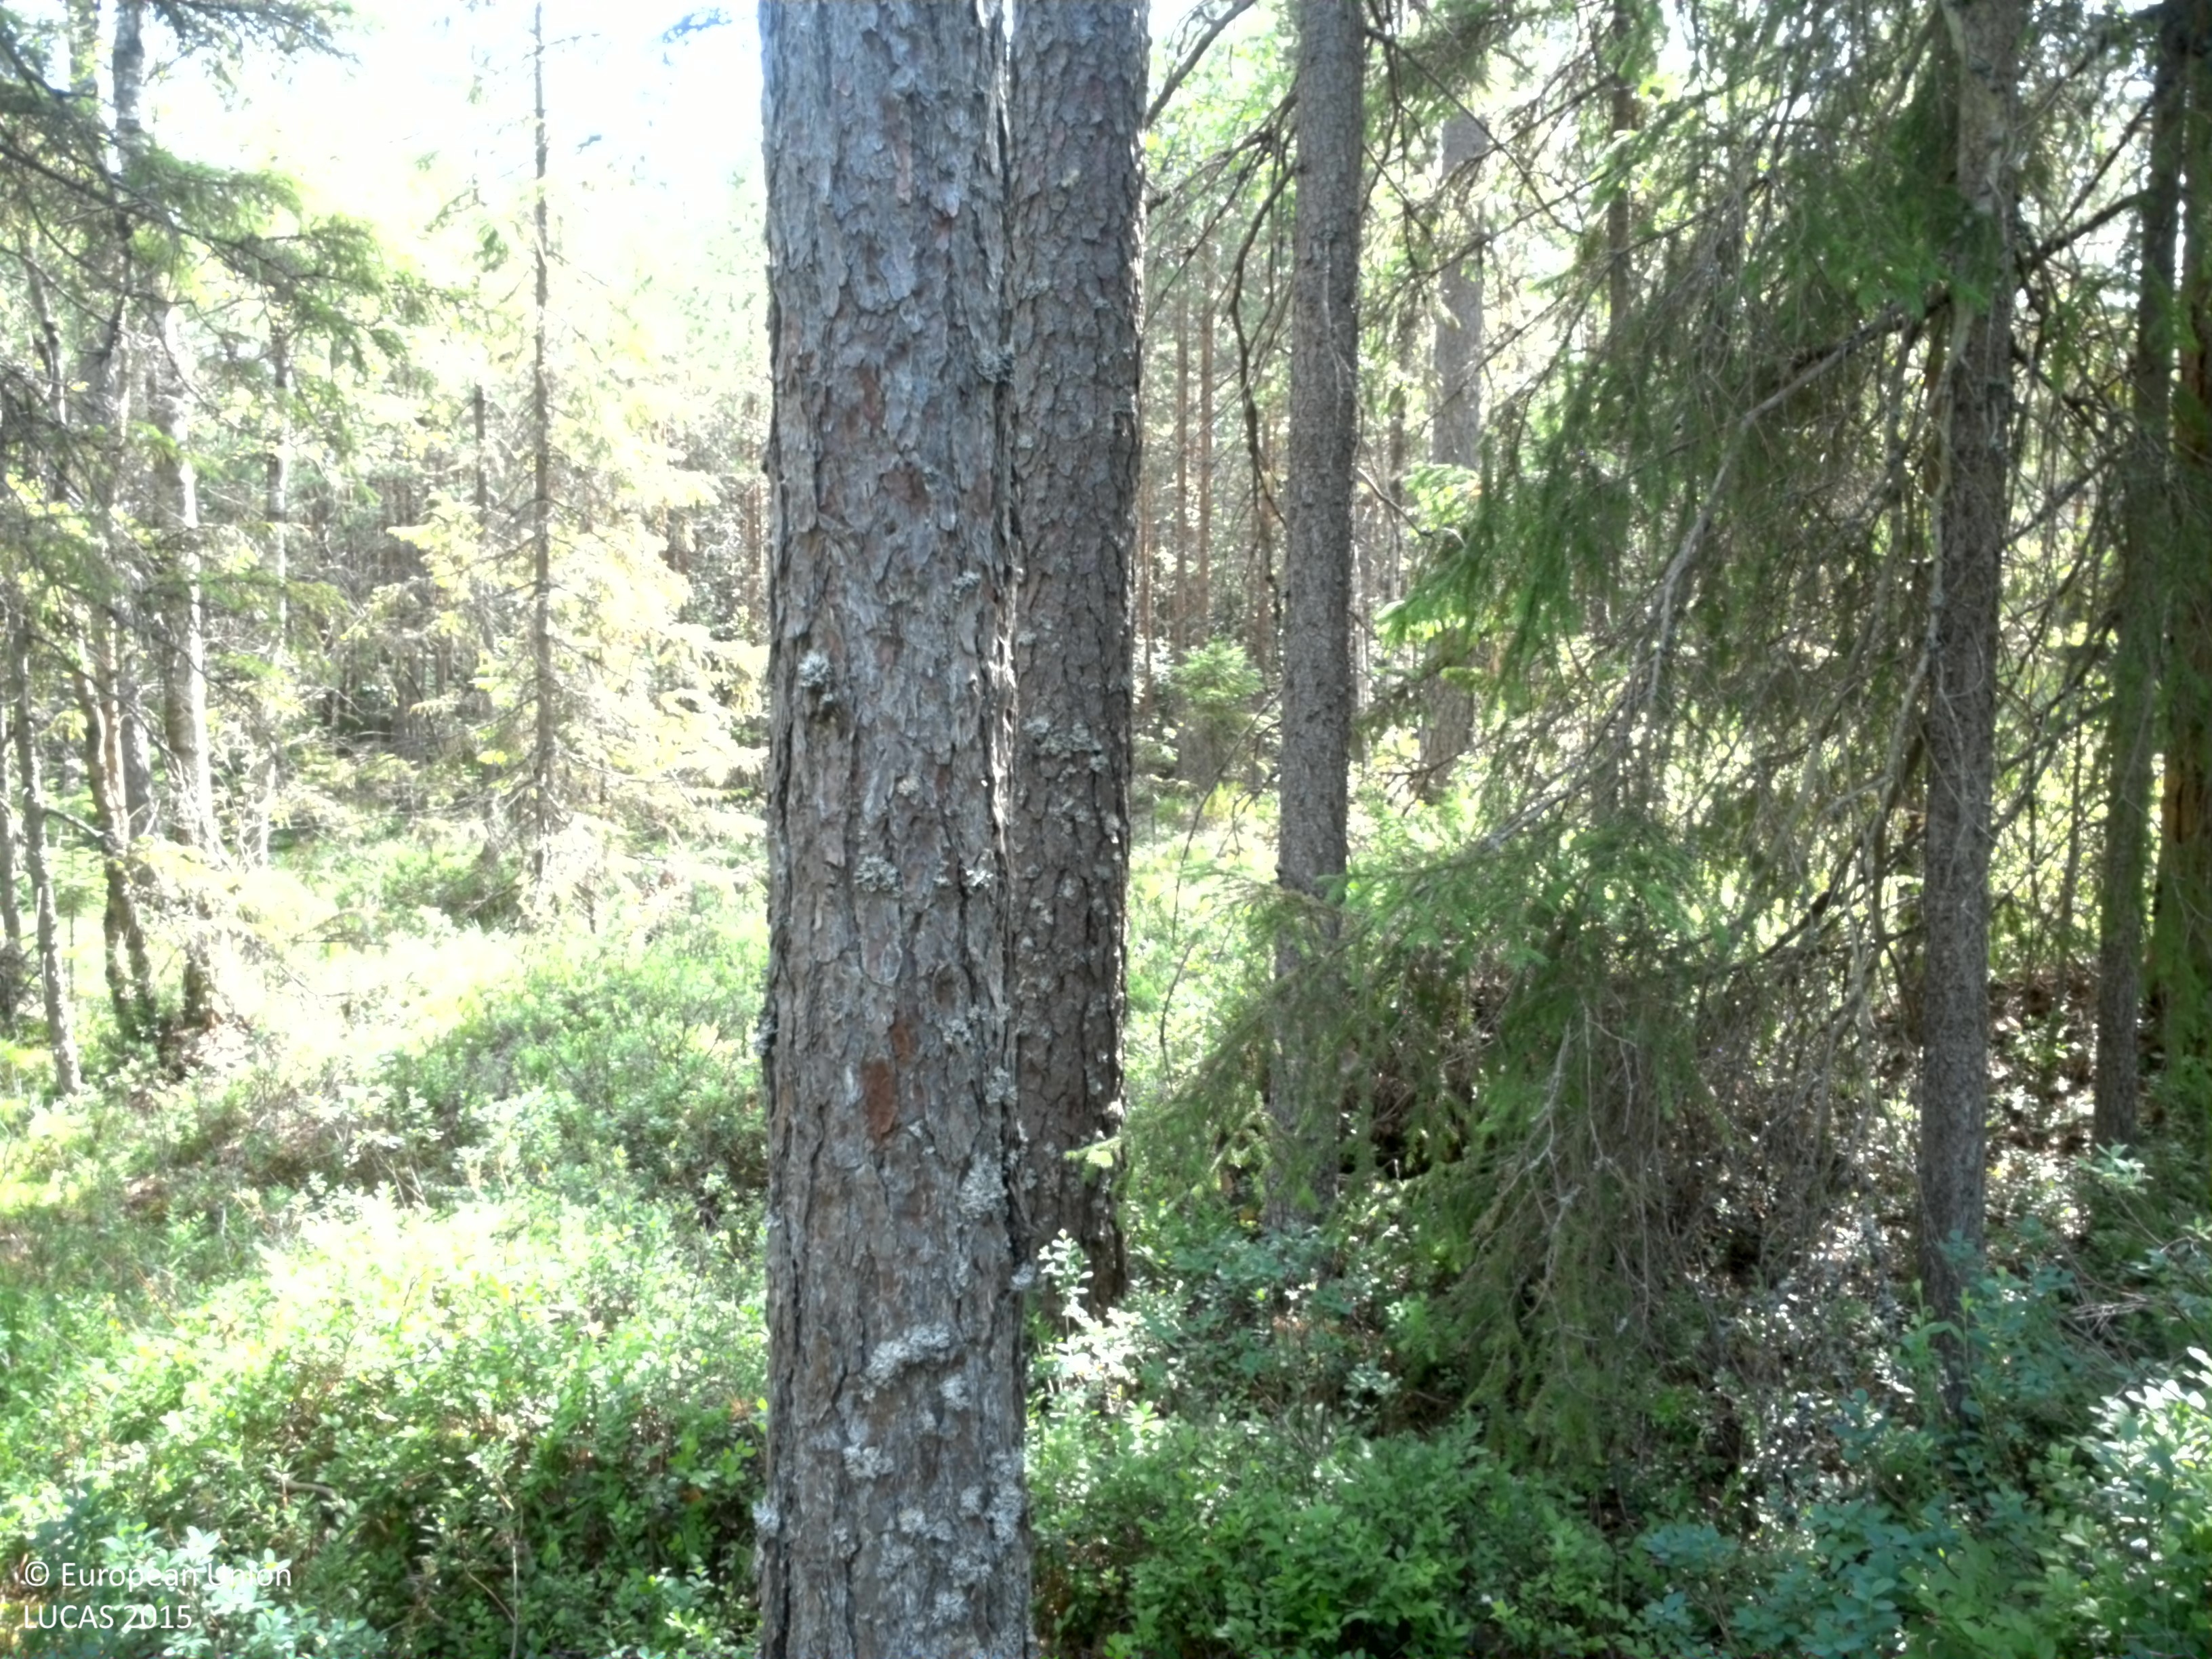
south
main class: Woodland
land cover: Pine dominated mixed woodland
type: boreal forest
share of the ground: 50 - 75 %
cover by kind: coniferous forest trees 50 %, broadleaved forest trees 20 %, shrubs 15 %, herbaceous plants 10 %, consolidated bare surface 5 %
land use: Forestry
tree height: > 5 m
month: July
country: SE
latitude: 59.2772
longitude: 14.5718
